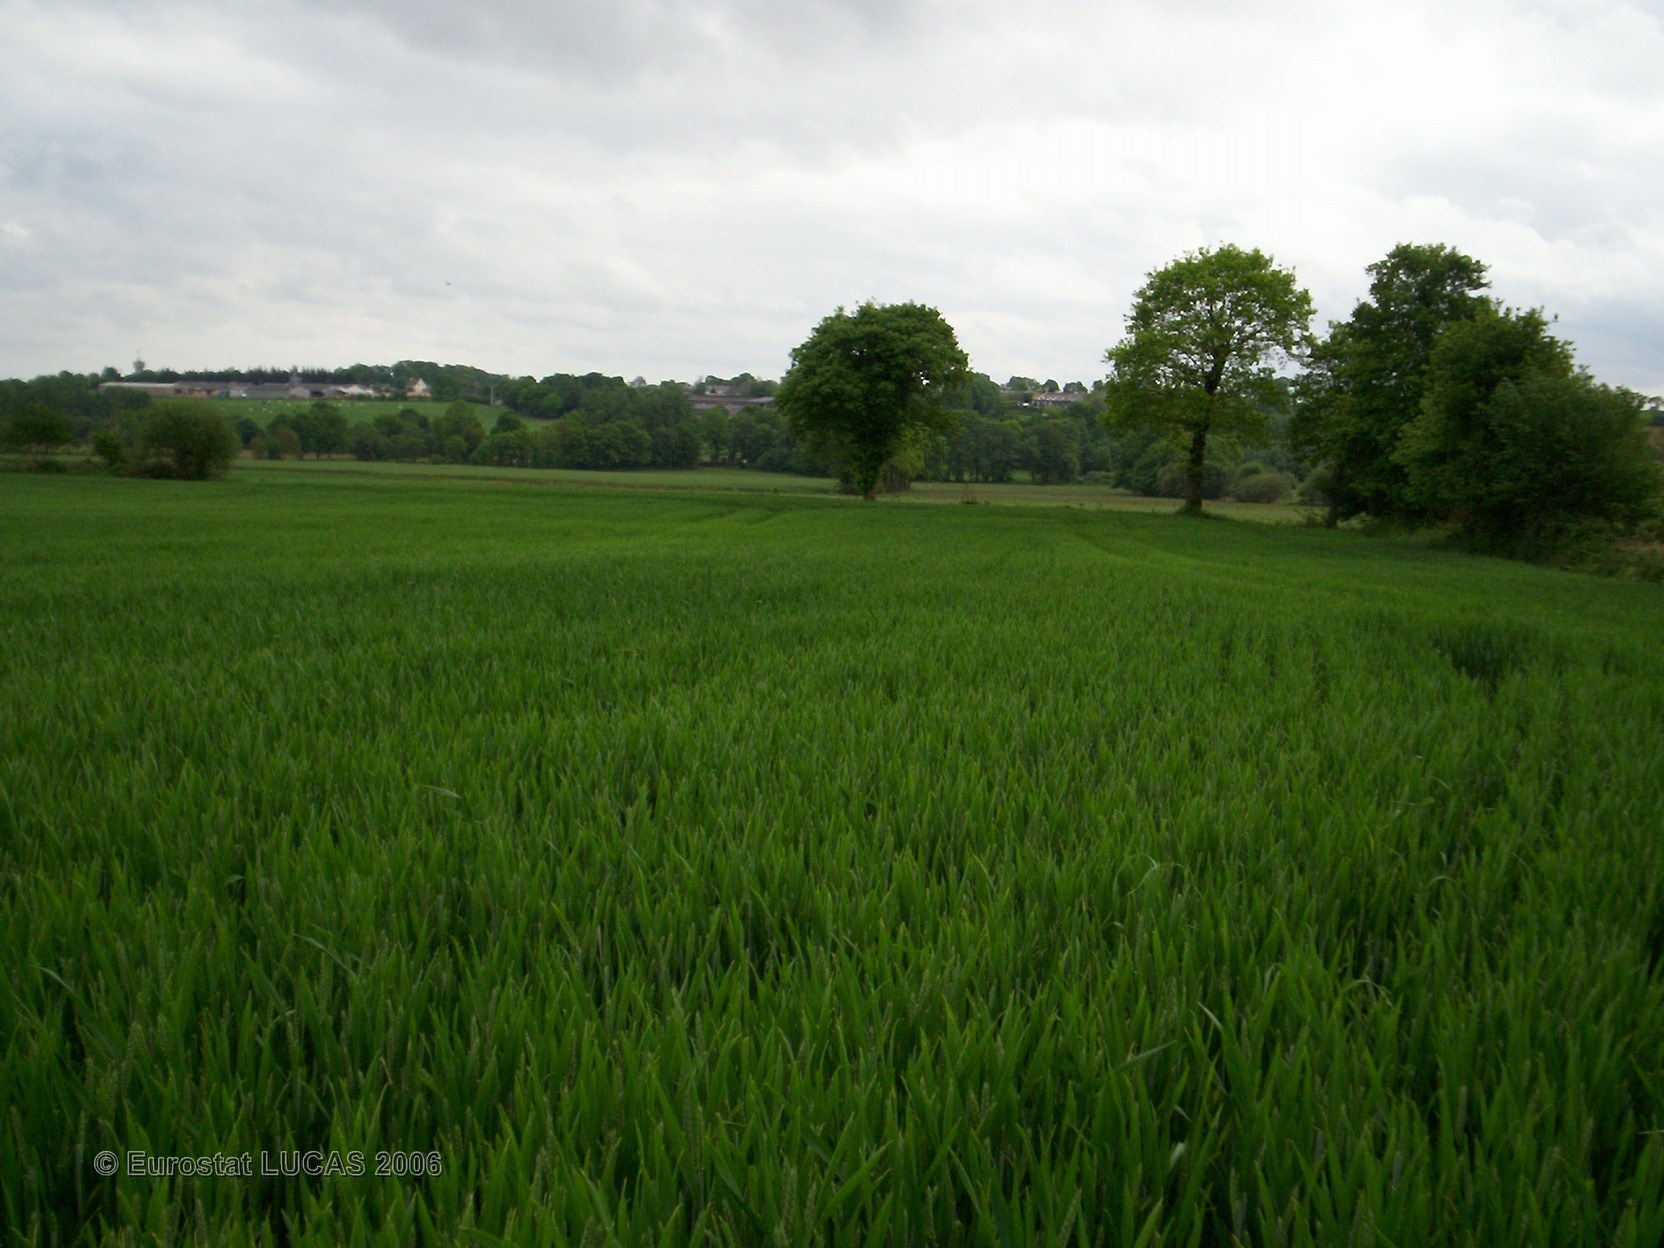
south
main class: Cropland
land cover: Common wheat
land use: Agriculture (excluding fallow land and kitchen gardens)
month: May
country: FR
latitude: 48.2090
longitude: -2.4263
